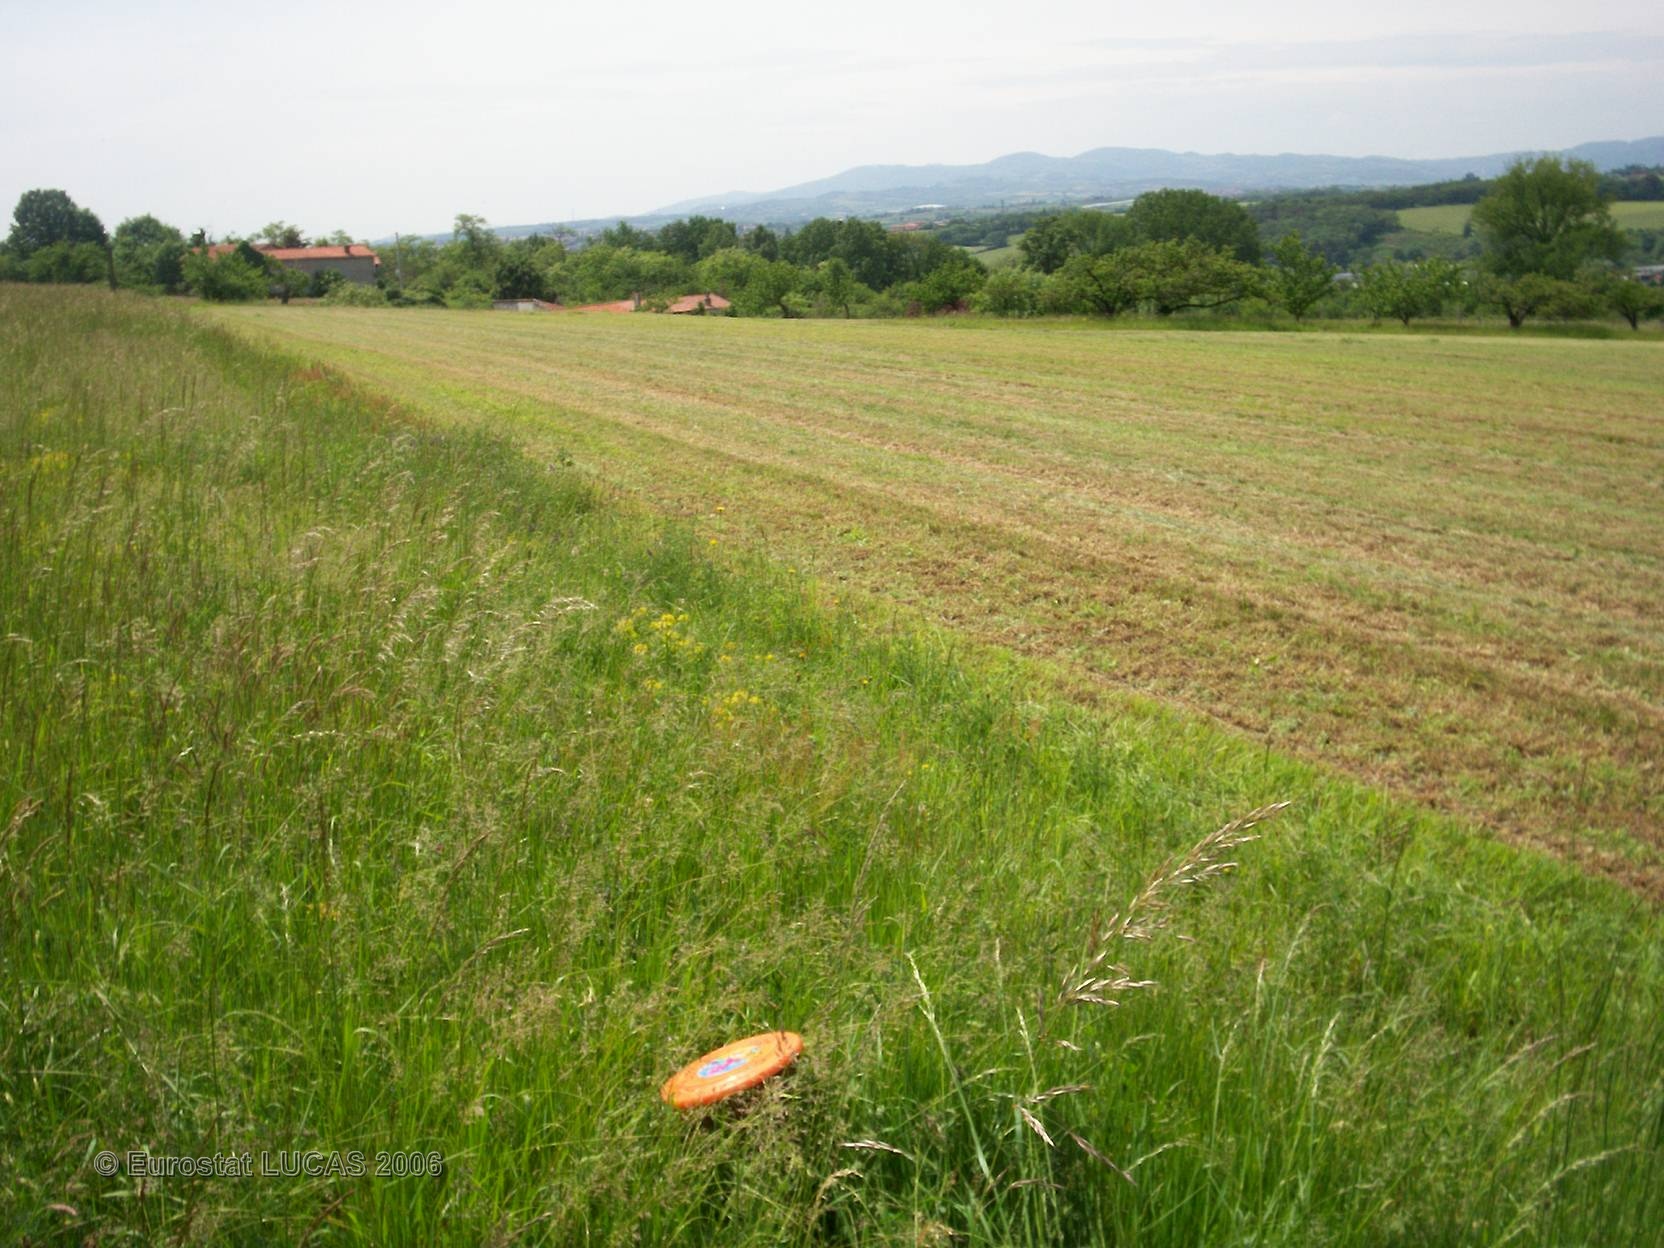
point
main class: Grassland
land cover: Grassland without tree/shrub cover
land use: Agriculture (excluding fallow land and kitchen gardens)
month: May
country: FR
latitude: 45.7001
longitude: 4.7764
